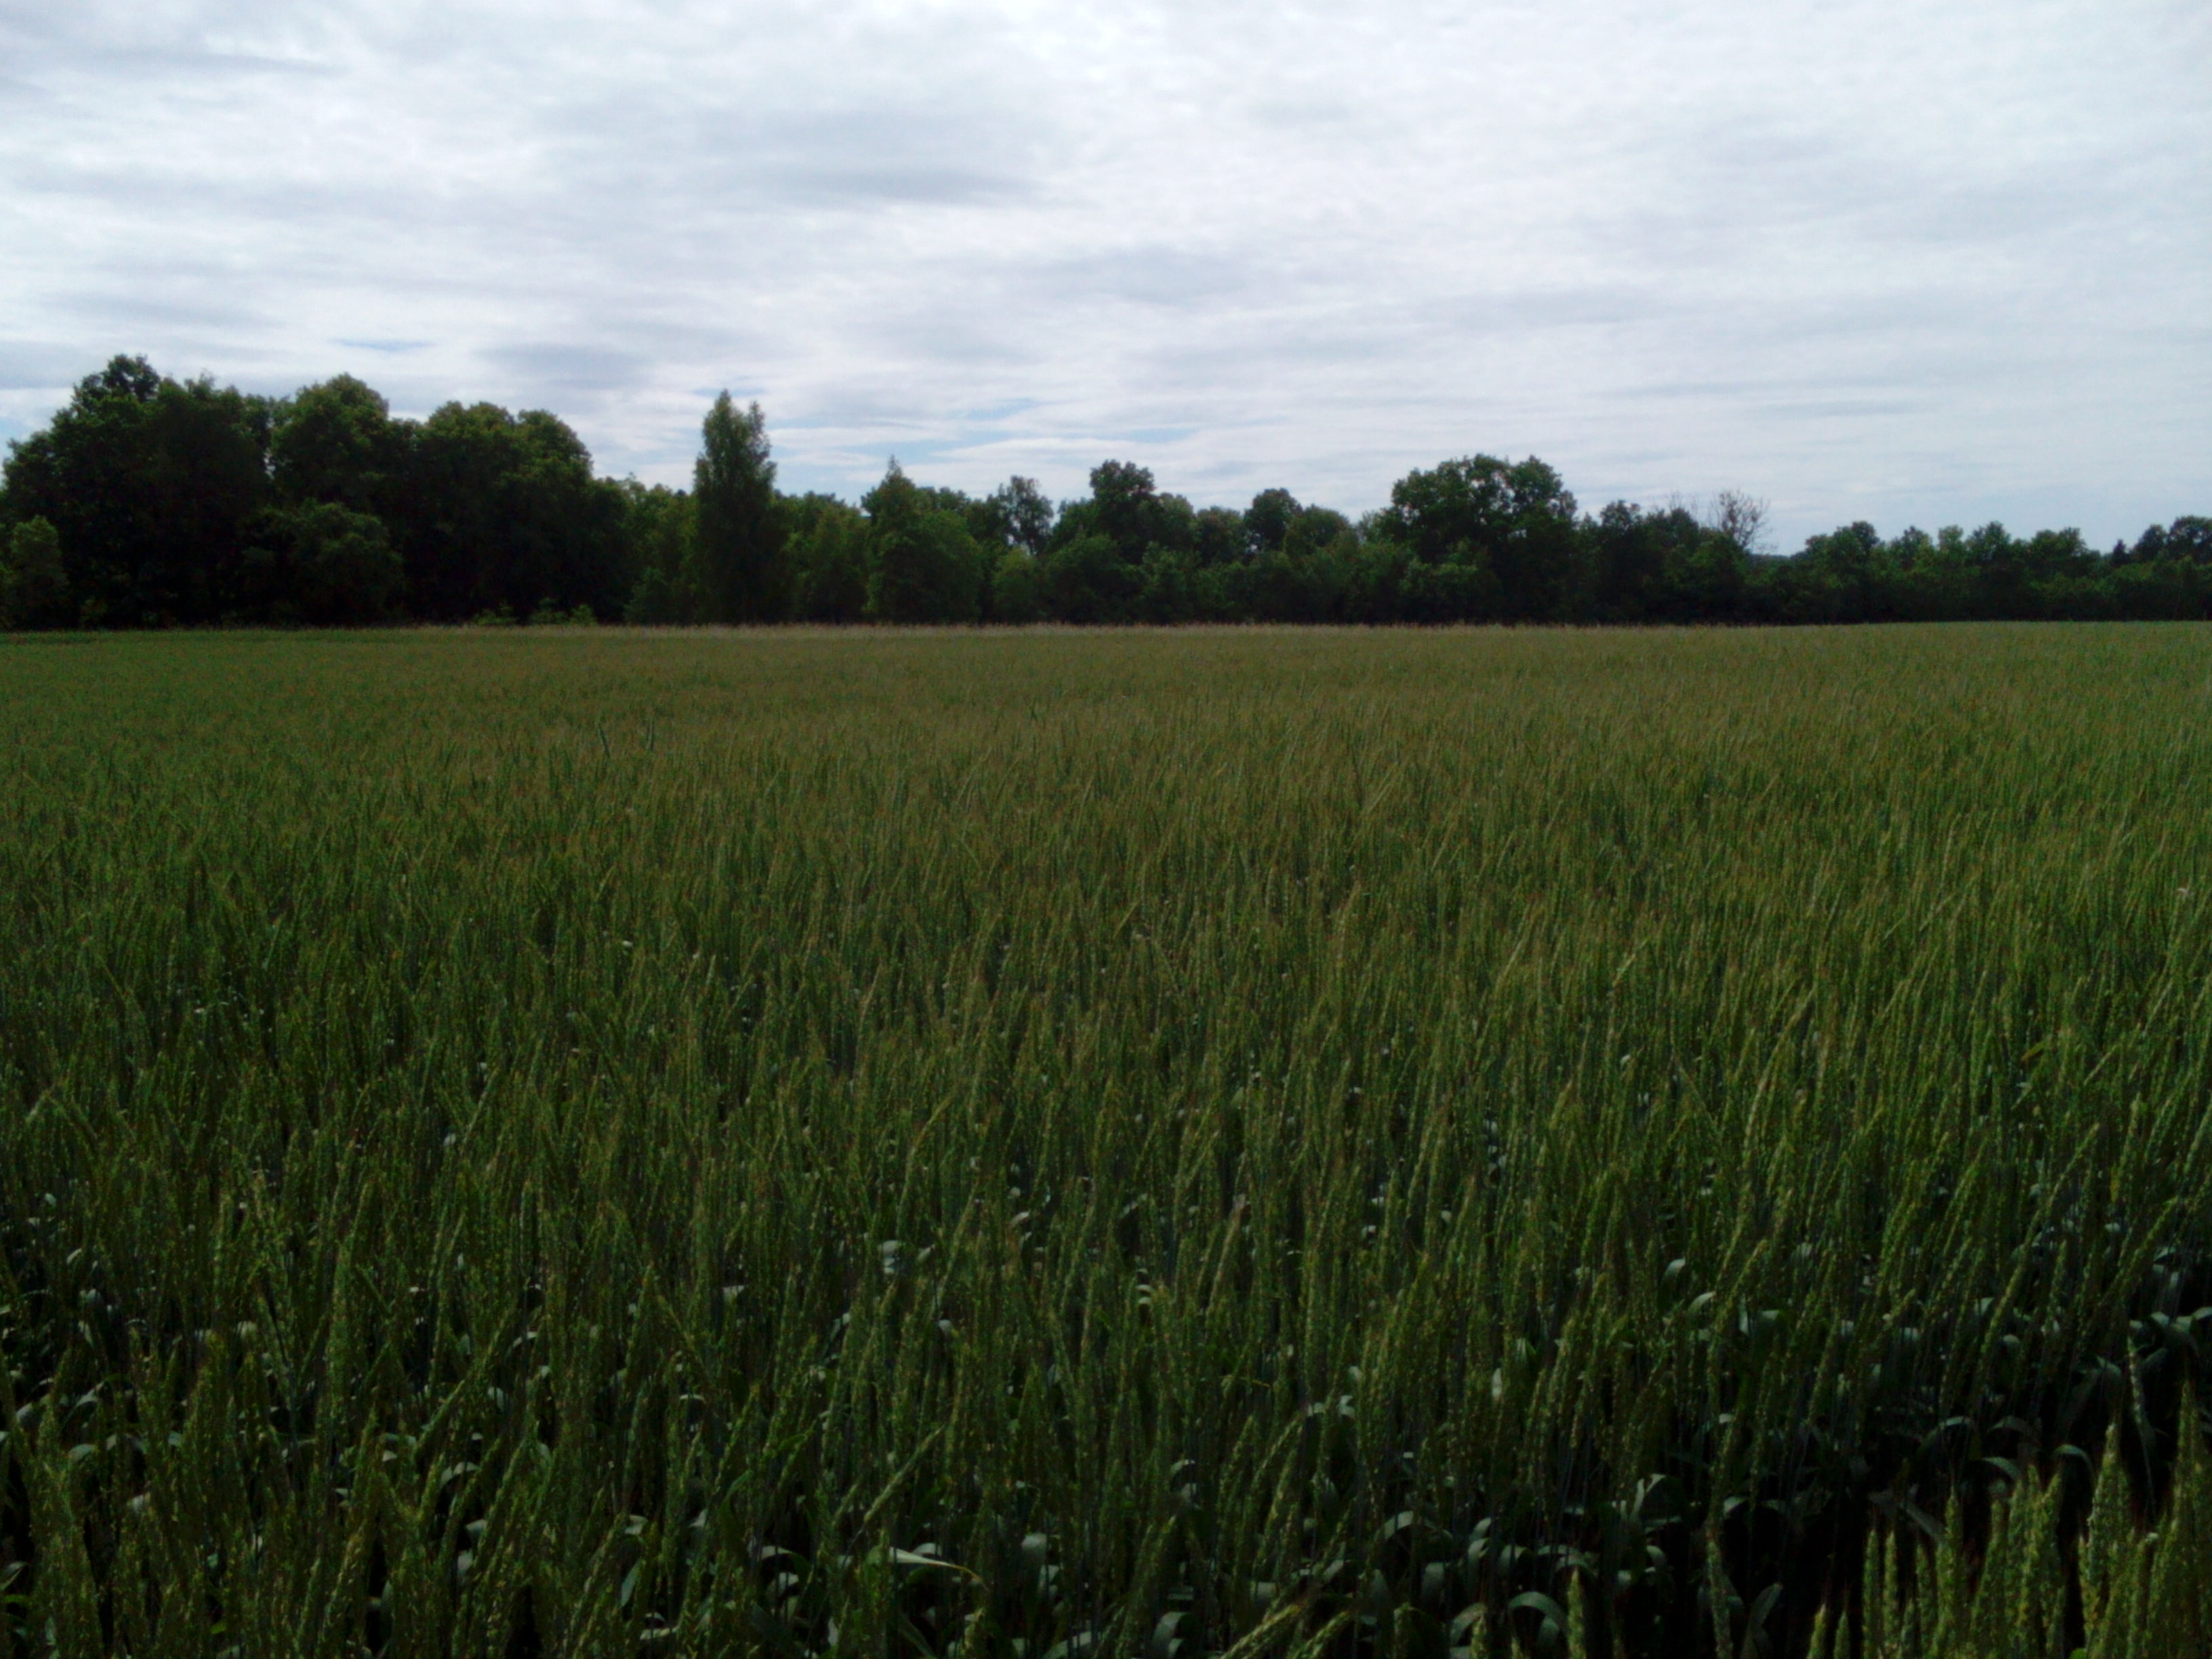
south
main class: Cropland
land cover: Common wheat
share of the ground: > 75 %
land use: Agriculture (excluding fallow land and kitchen gardens)
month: July
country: LV
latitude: 56.4612
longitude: 22.1751
